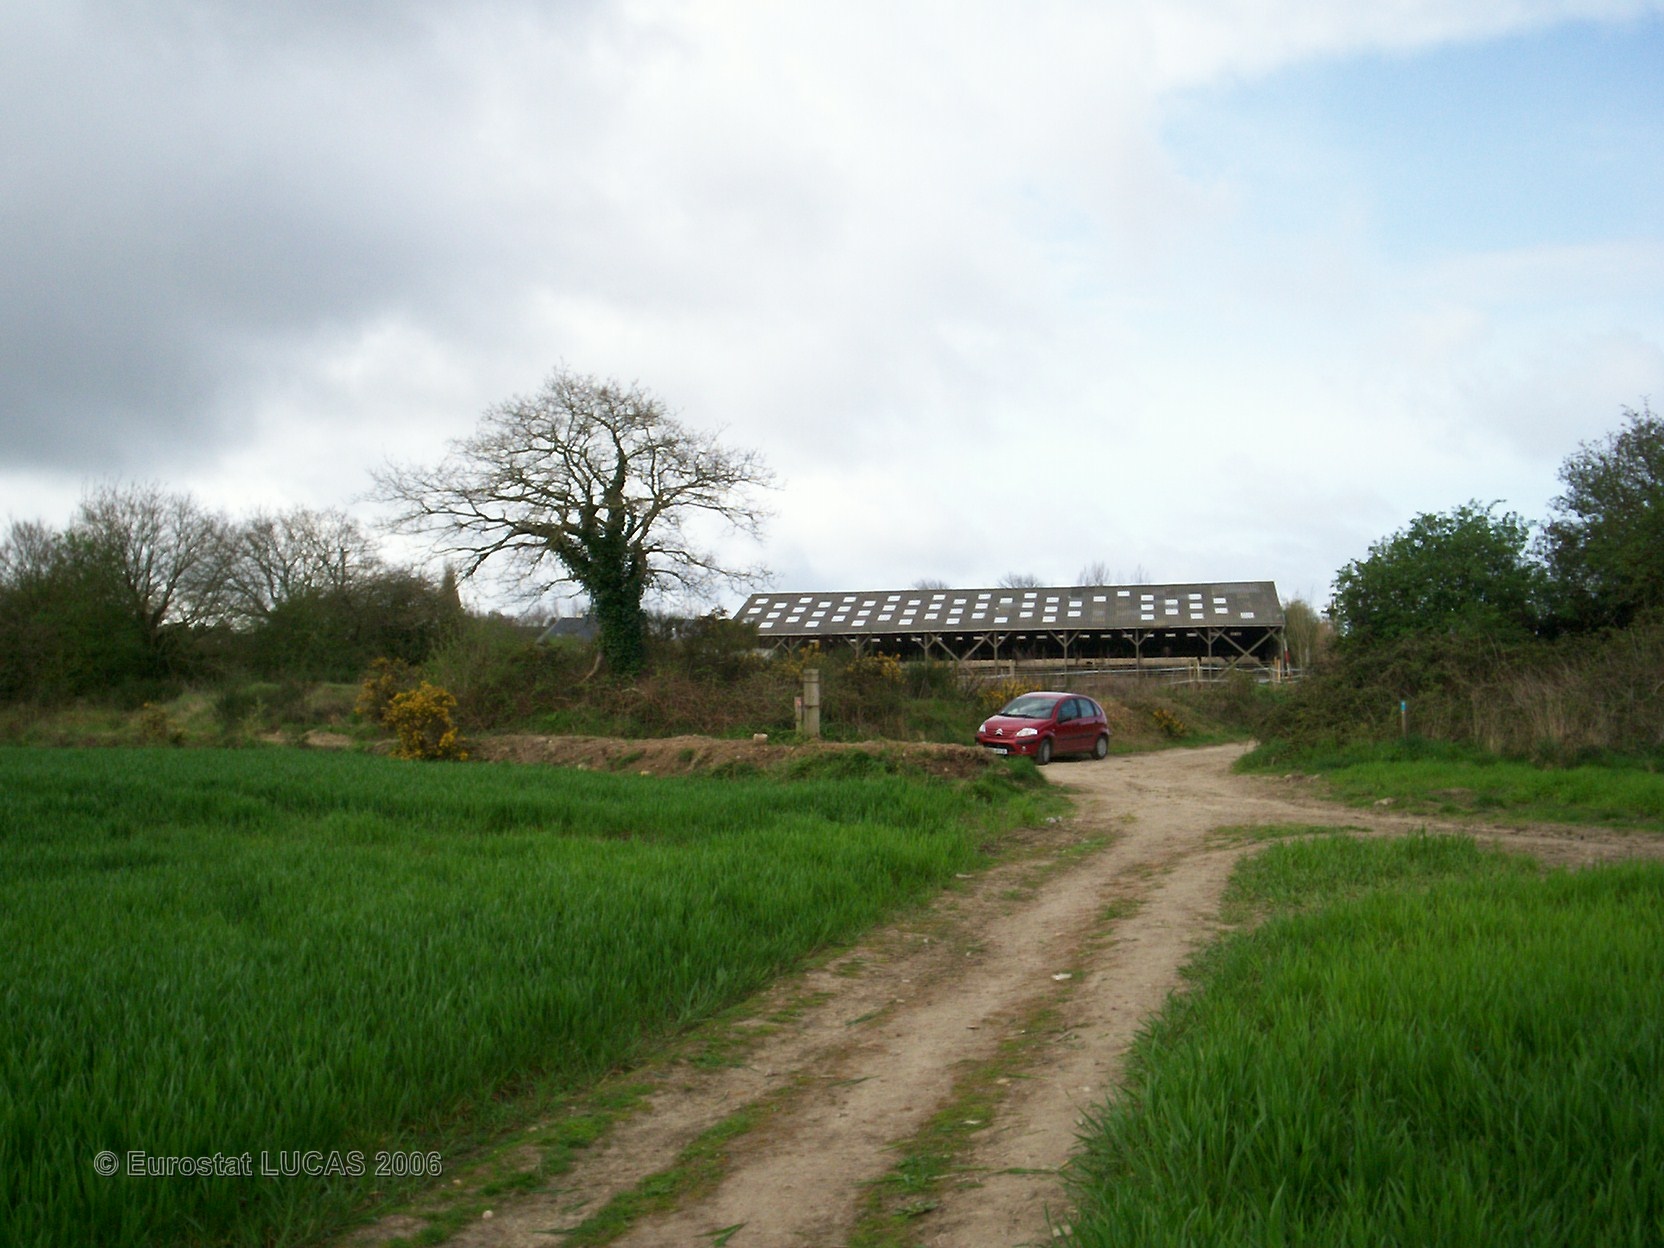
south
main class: Cropland
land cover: Triticale
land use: Agriculture (excluding fallow land and kitchen gardens)
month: April
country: FR
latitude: 47.7412
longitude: -3.4505
